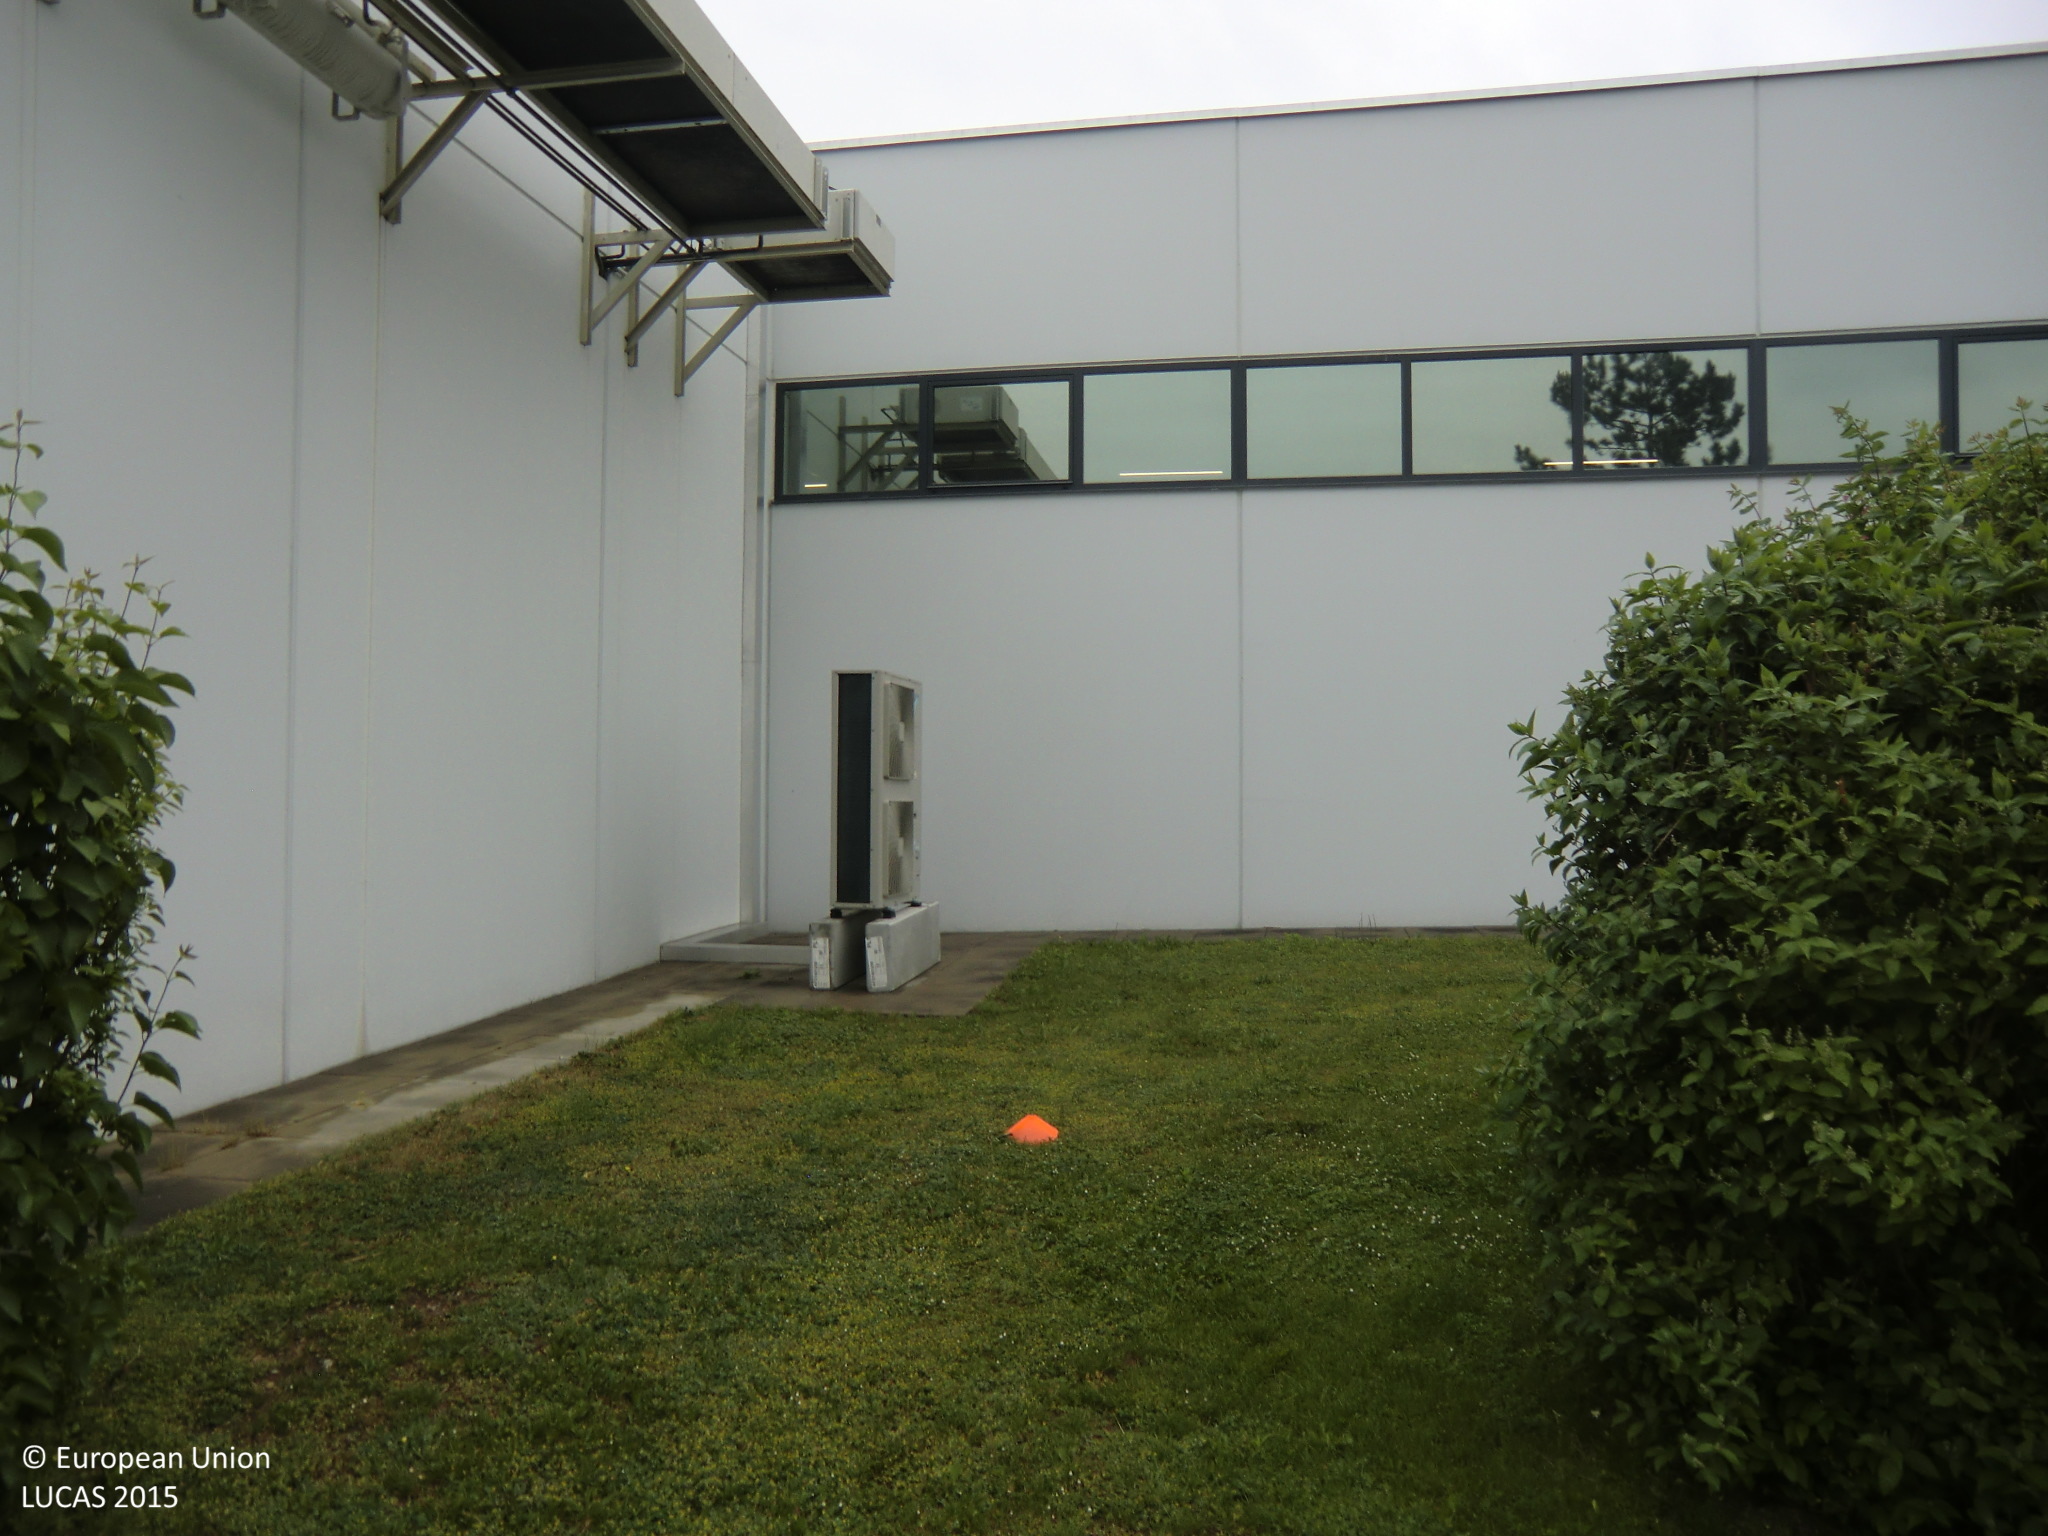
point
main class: Grassland
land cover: Grassland with sparse tree/shrub cover
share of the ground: > 75 %
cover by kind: herbaceous plants 90 %, broadleaved forest trees 5 %, shrubs 5 %
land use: Commerce
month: May
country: AT
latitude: 47.2846
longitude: 15.9909
